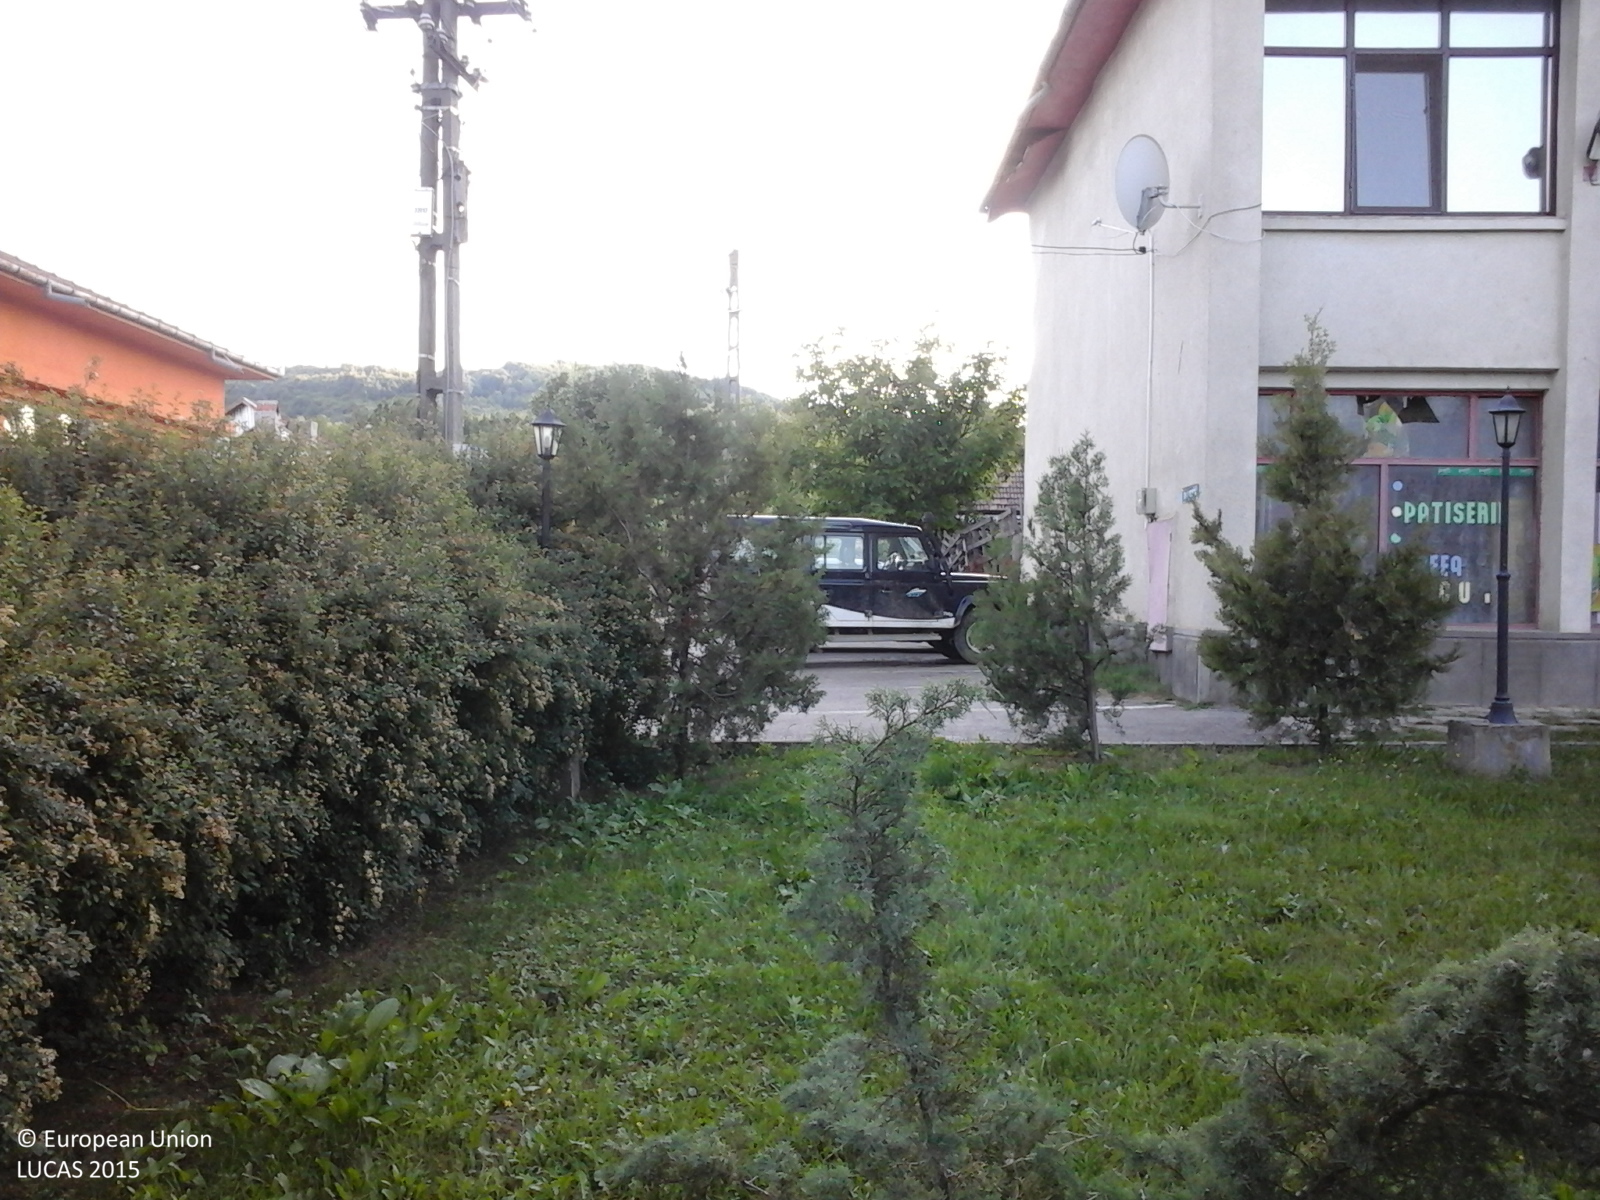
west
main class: Grassland
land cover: Grassland with sparse tree/shrub cover
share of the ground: > 75 %
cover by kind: herbaceous plants 95 %, broadleaved forest trees 5 %
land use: Amenities, museums, leisure
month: May
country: RO
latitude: 45.3194
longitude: 26.3598
